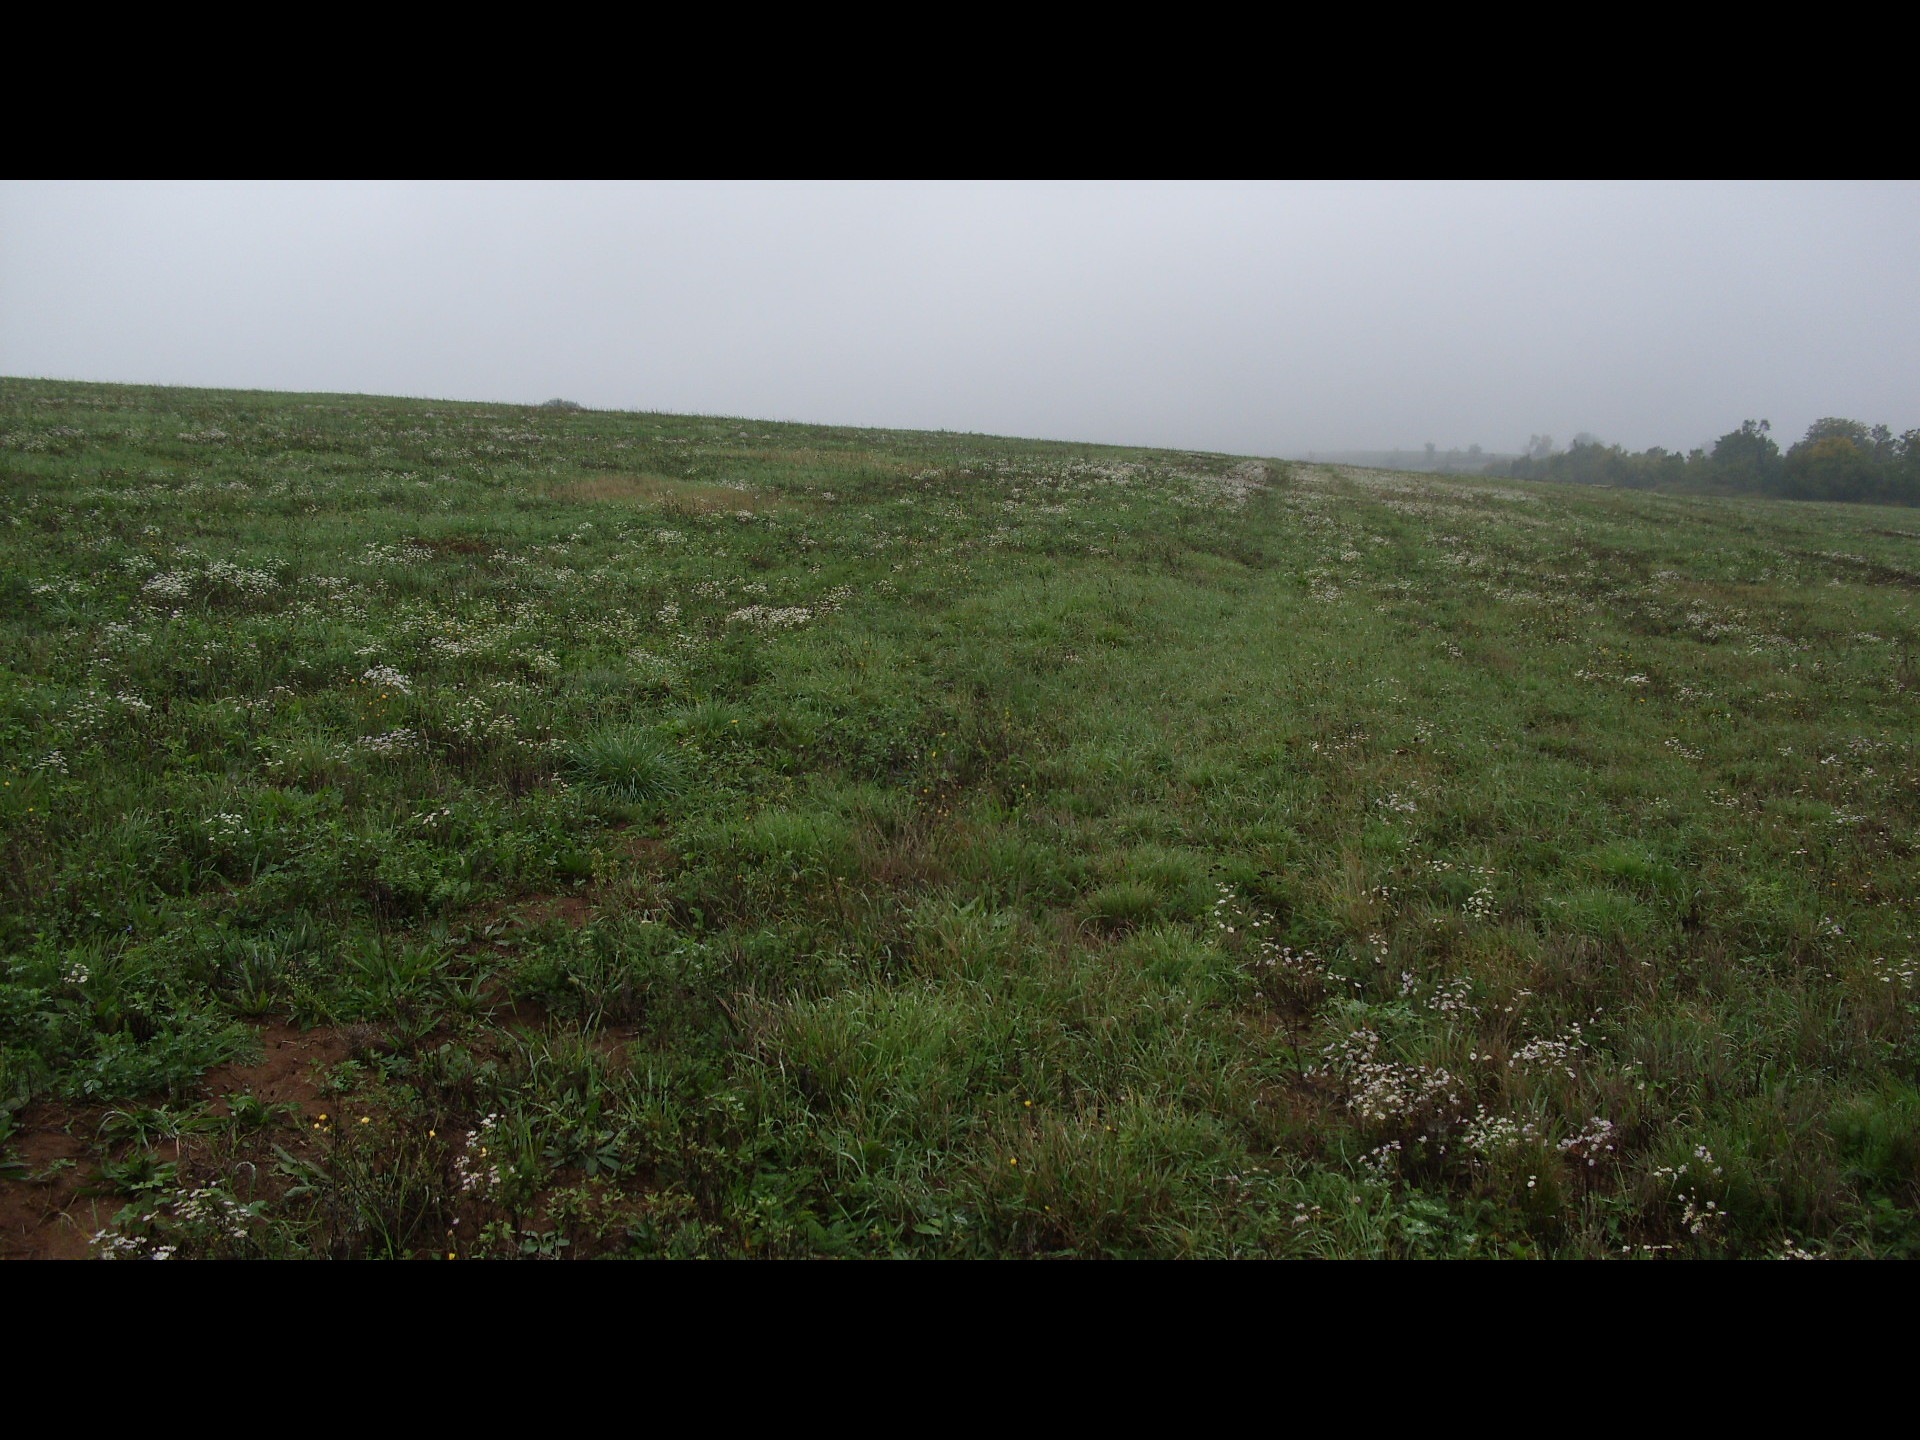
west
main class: Grassland
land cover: Grassland without tree/shrub cover
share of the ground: > 75 %
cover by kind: herbaceous plants 100 %
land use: Agriculture (excluding fallow land and kitchen gardens)
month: October
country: BG
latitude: 43.5343
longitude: 22.6672
